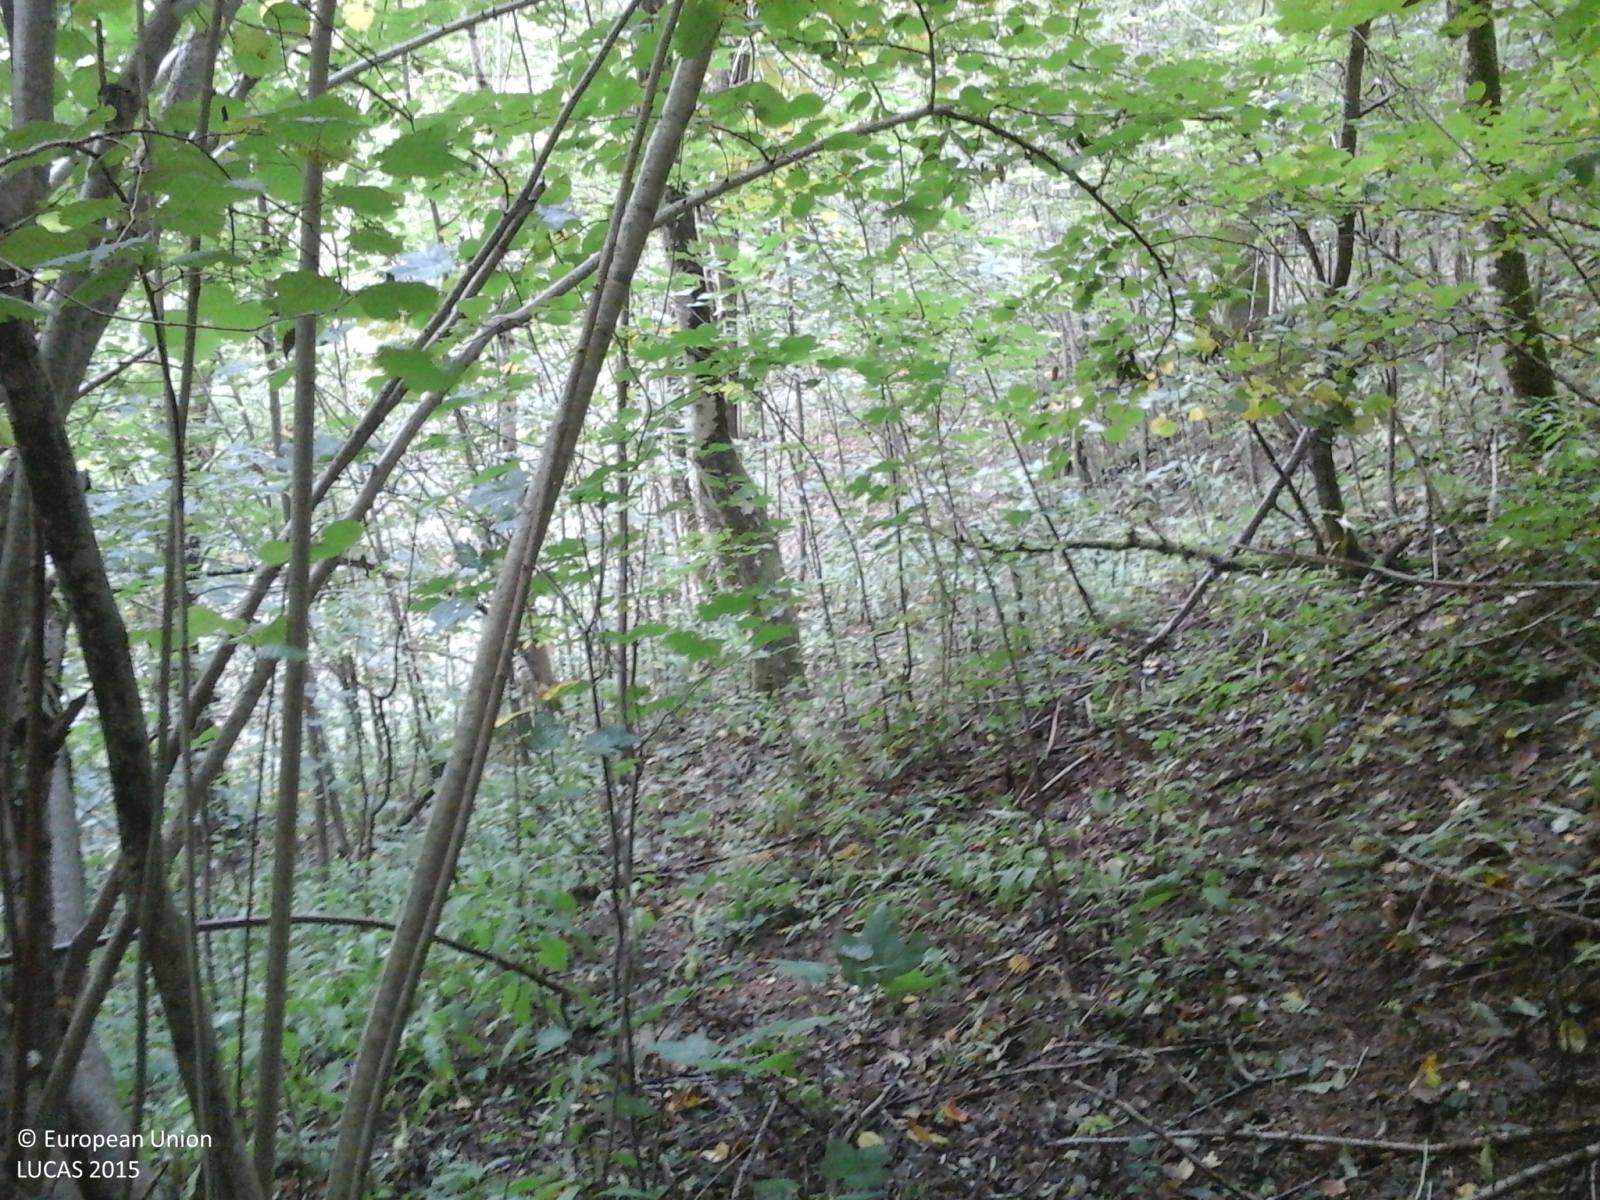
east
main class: Woodland
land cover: Broadleaved woodland
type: thermophilous deciduous forest
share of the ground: > 75 %
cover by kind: broadleaved forest trees 100 %
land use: Semi-natural and natural areas not in use
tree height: > 5 m
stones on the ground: 10 - 25 %
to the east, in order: Broadleaved woodland; Paved roads, cycling and walking lanes; Broadleaved woodland; Electric lines; Broadleaved woodland
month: September
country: IT
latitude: 44.5099
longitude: 9.2093
